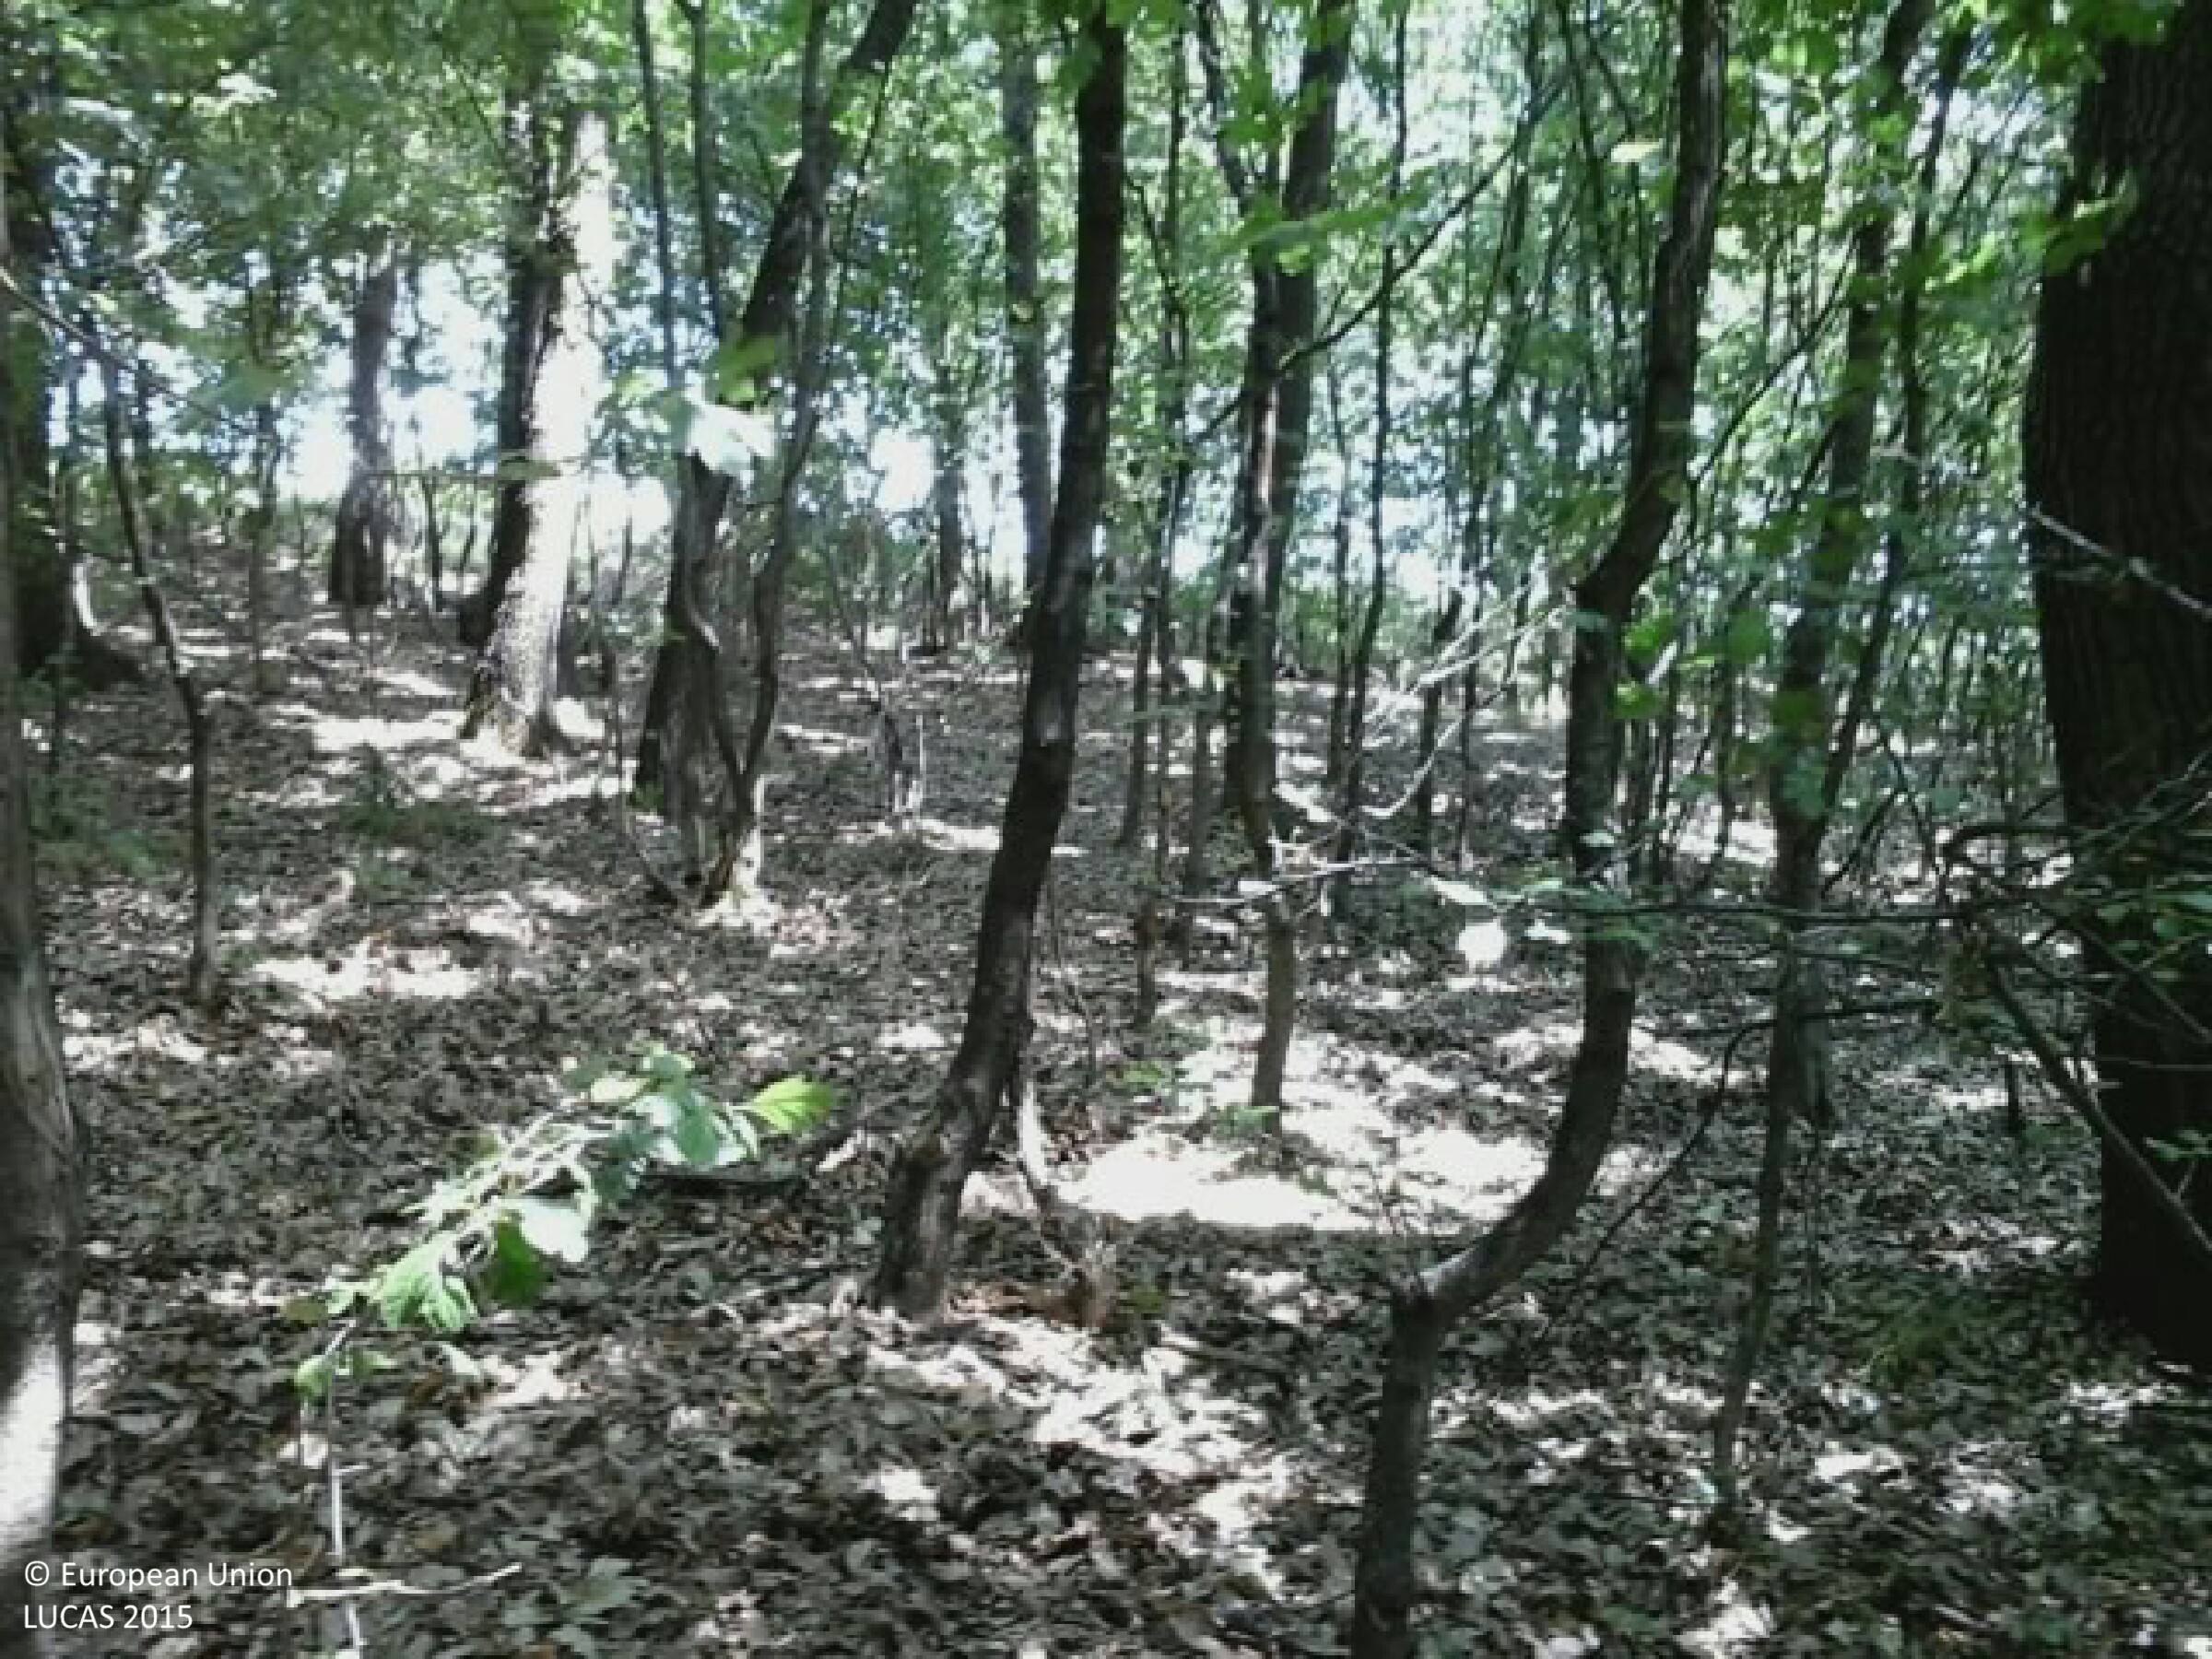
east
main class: Woodland
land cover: Broadleaved woodland
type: mesophytic deciduous forest
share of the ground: > 75 %
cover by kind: broadleaved forest trees 100 %
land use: Forestry
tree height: > 5 m
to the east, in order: Broadleaved woodland; Grass margins; Tracks; Shruby margins; Grassland without tree/shrub cover; Spontaneously vegetated surfaces; Electric lines; Spontaneously vegetated surfaces; Grassland without tree/shrub cover
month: July
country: HU
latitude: 47.8649
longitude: 19.0962
